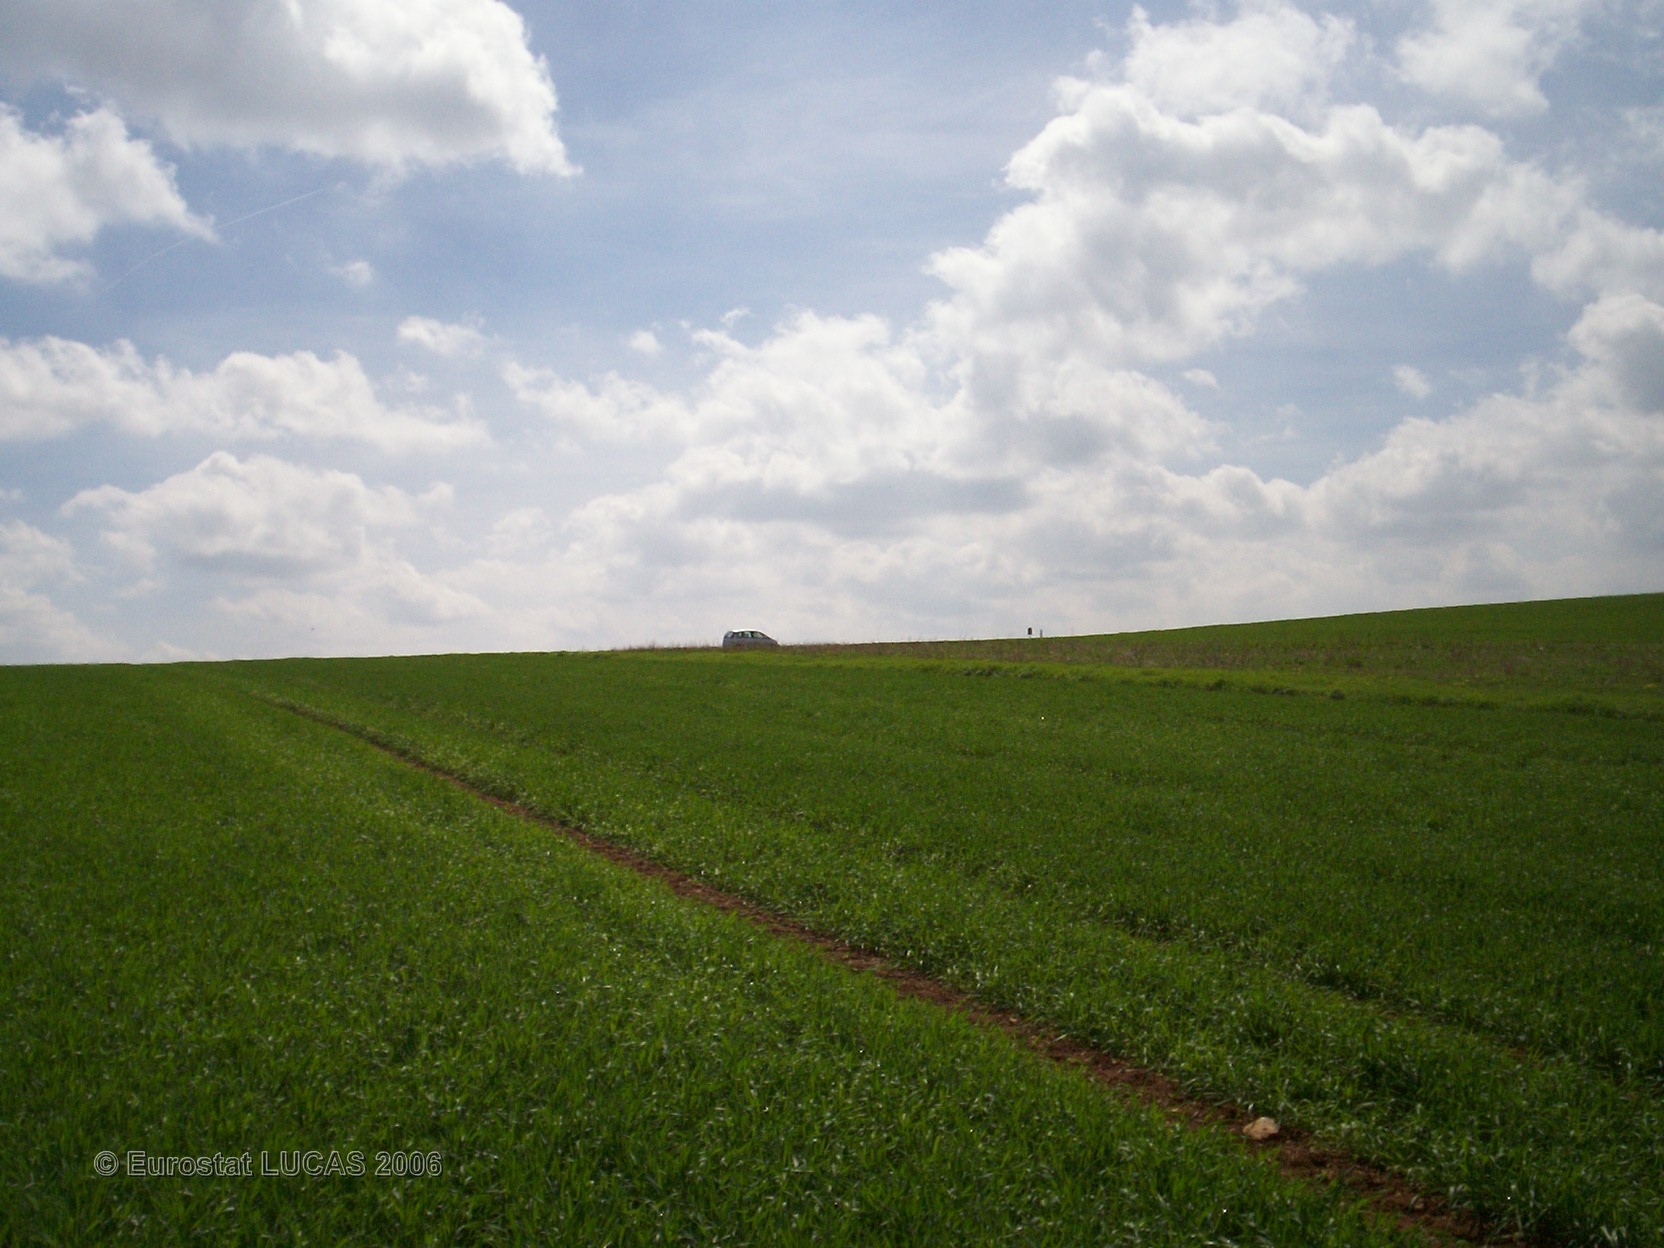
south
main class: Cropland
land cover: Common wheat
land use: Agriculture (excluding fallow land and kitchen gardens)
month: May
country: FR
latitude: 49.8121
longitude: 4.3953
